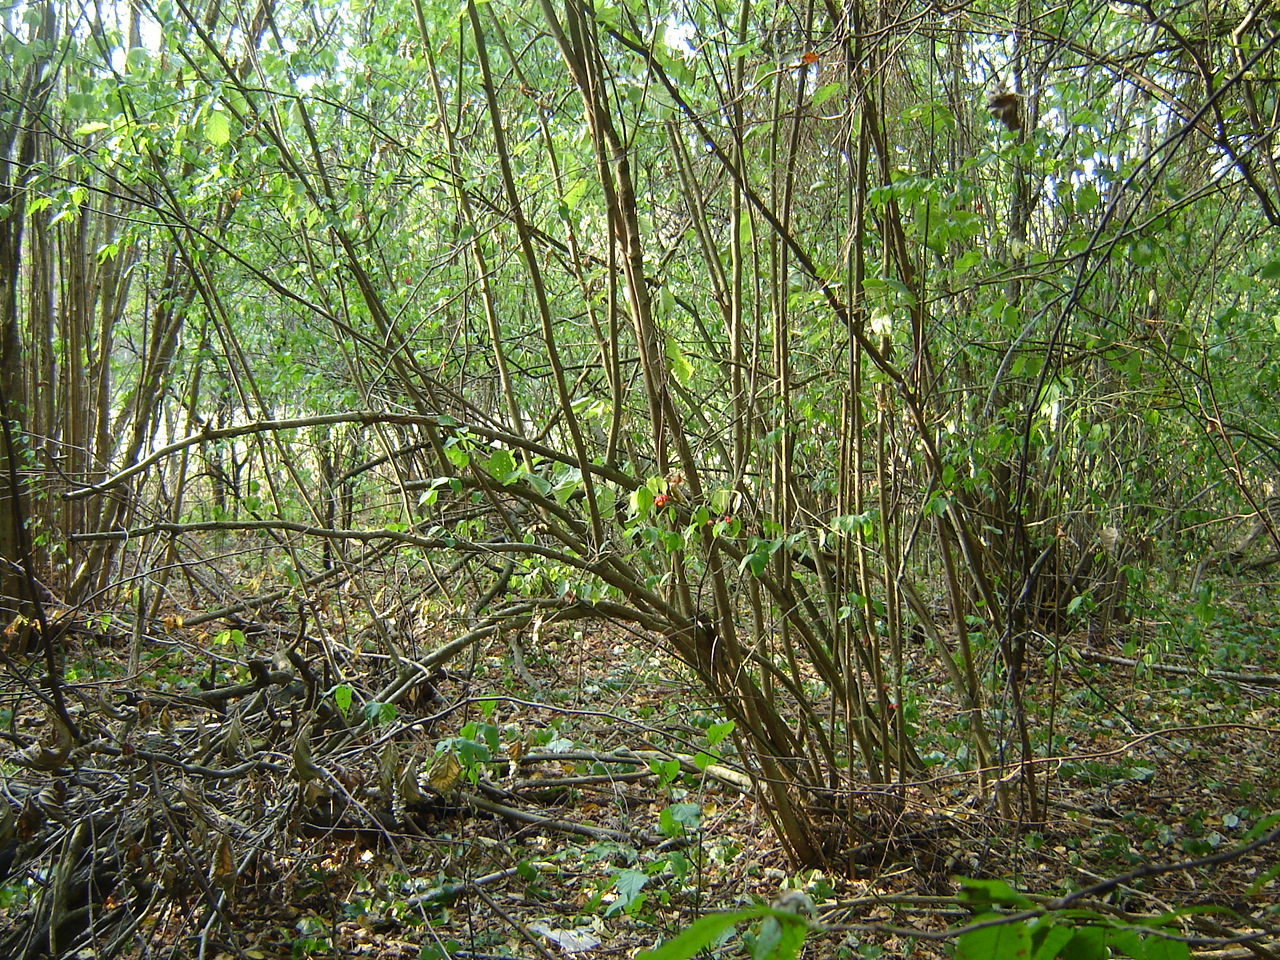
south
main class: Woodland
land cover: Spruce dominated mixed woodland
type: hemiboreal forest and nemoral coniferous forest and mixed broadleaved-coniferous forest
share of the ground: > 75 %
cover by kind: broadleaved forest trees 55 %, coniferous forest trees 30 %, unconsolidated bare surface 10 %, herbaceous plants 5 %
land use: Forestry
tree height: > 5 m
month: September
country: LT
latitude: 54.5037
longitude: 25.2075
